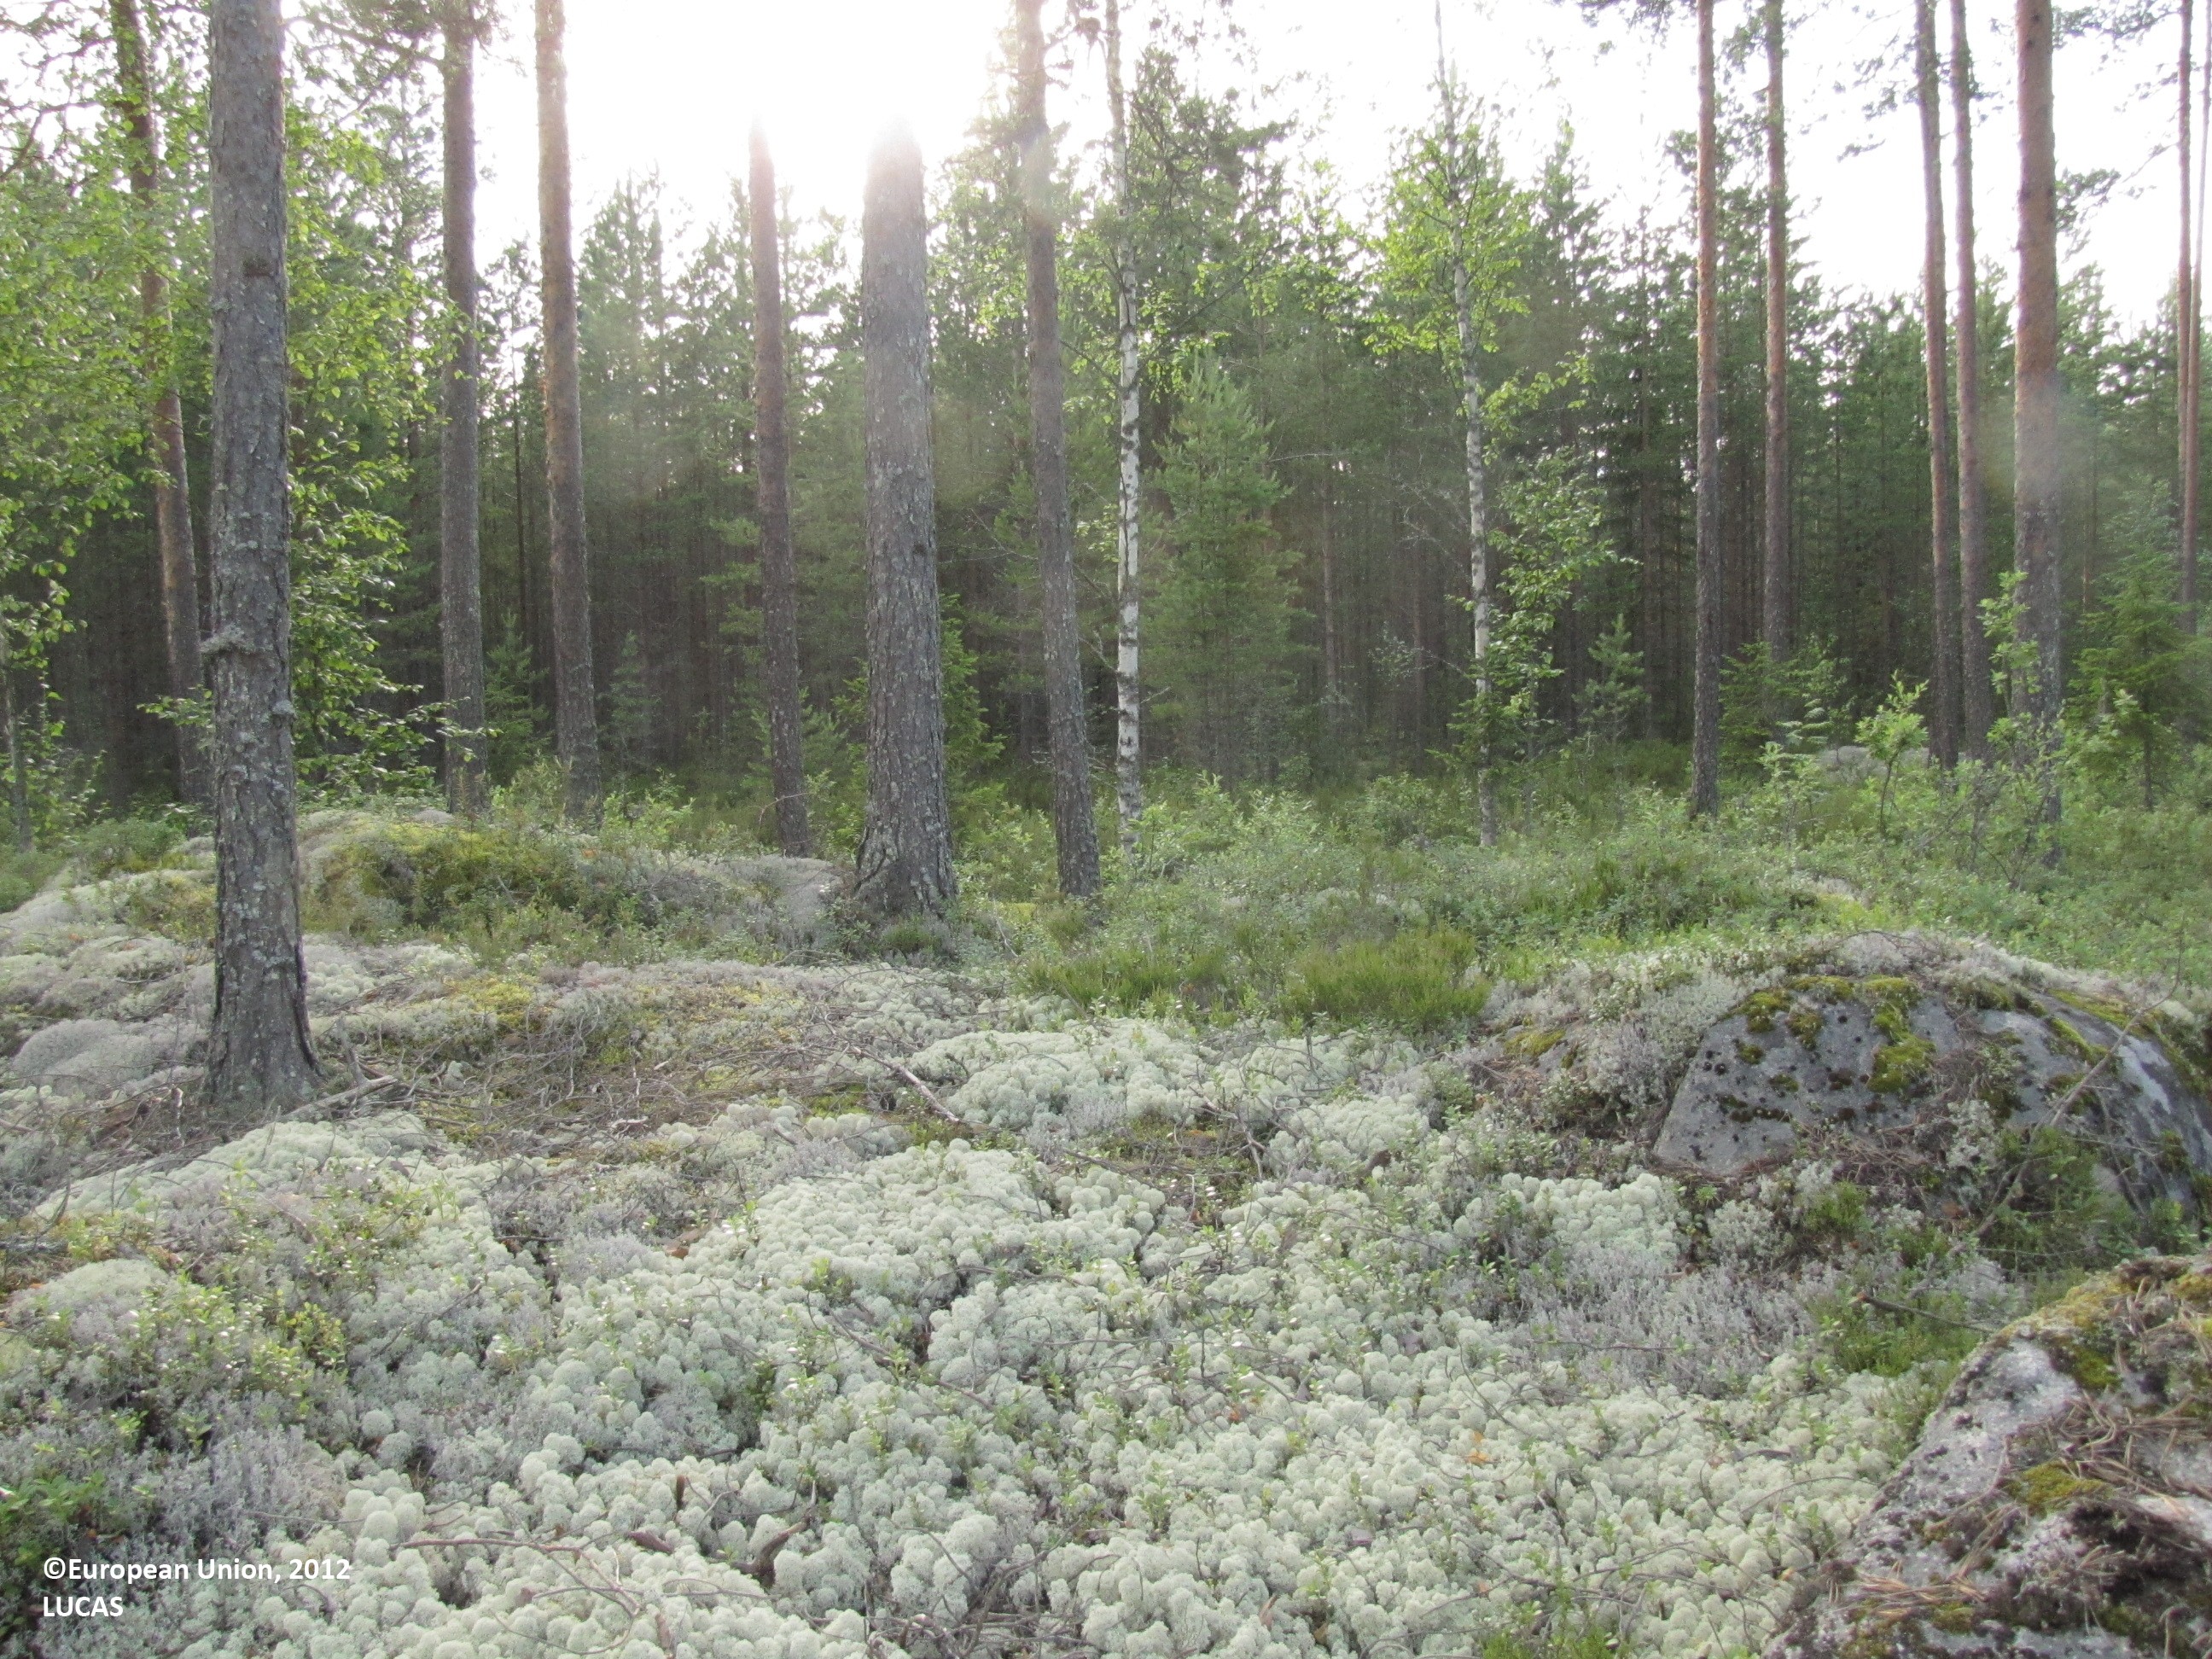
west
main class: Woodland
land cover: Pine dominated coniferous woodland
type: boreal forest
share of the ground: > 75 %
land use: Forestry
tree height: > 5 m
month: July
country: FI
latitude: 62.5259
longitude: 23.5756
